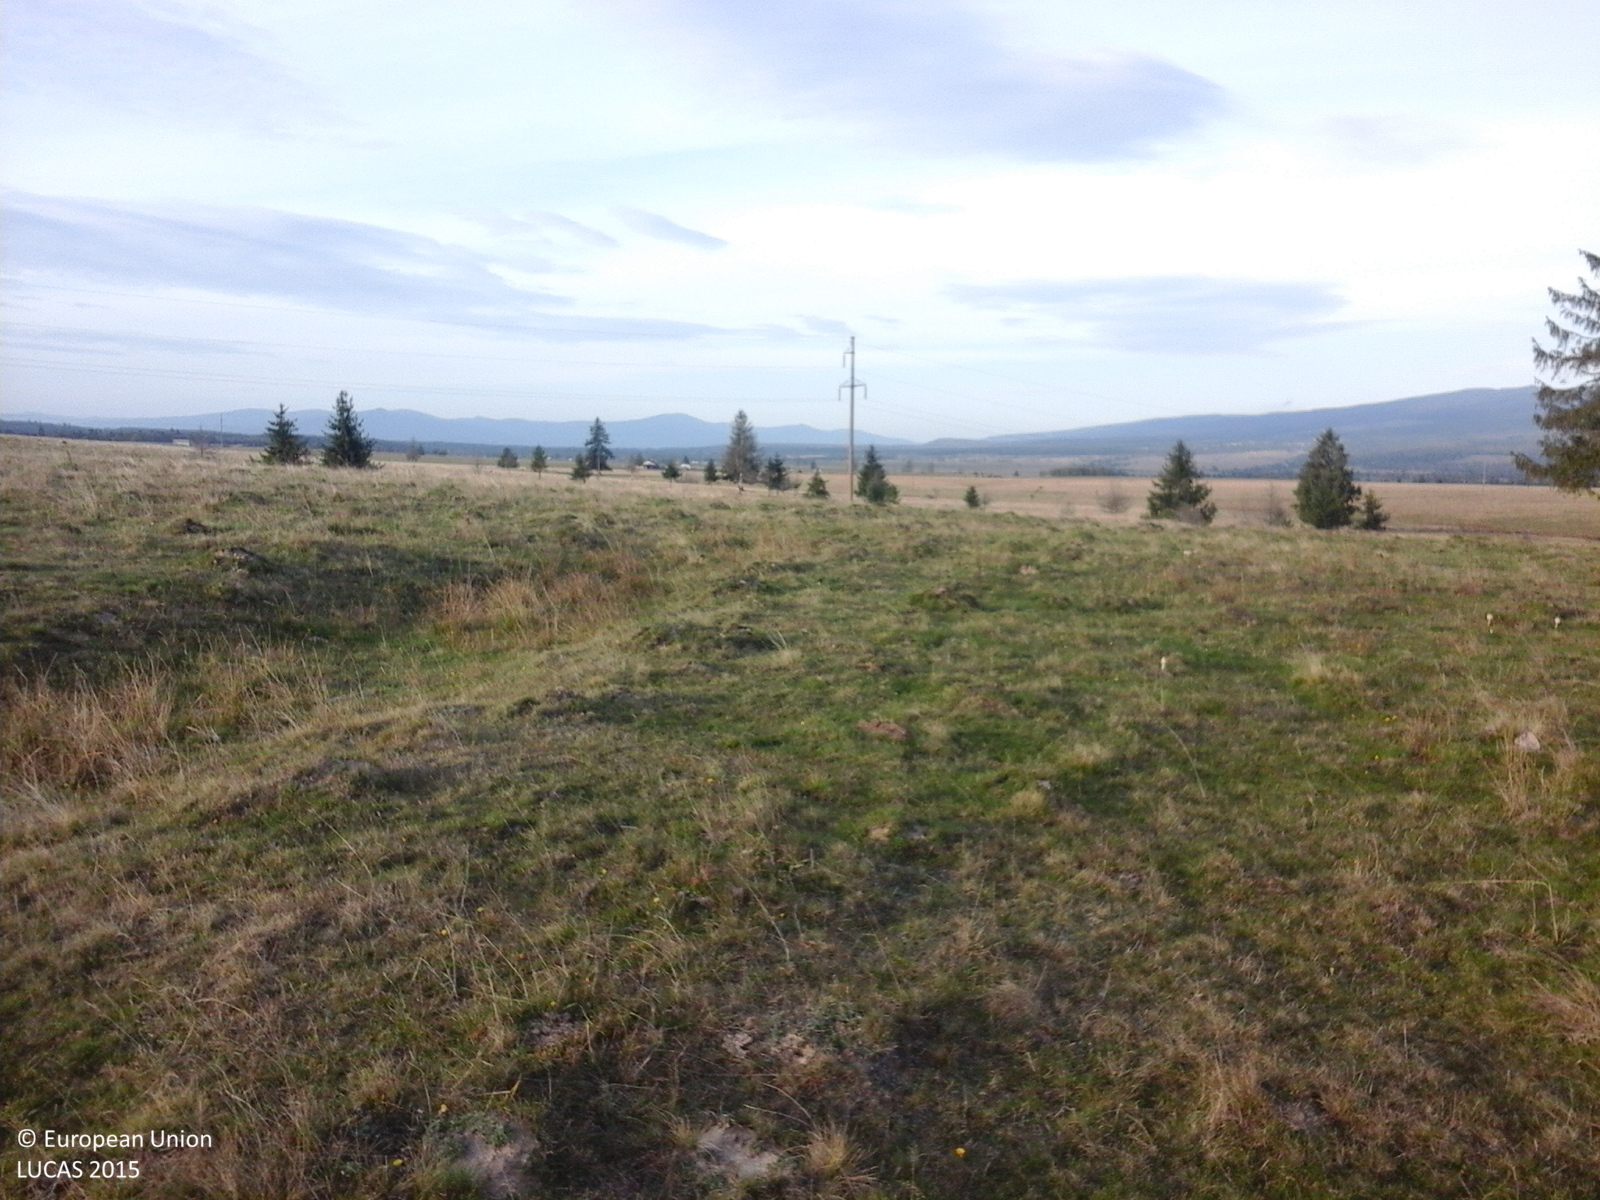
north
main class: Grassland
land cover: Grassland without tree/shrub cover
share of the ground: > 75 %
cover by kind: herbaceous plants 100 %
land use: Agriculture (excluding fallow land and kitchen gardens)
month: October
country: RO
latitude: 46.3380
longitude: 25.4497
